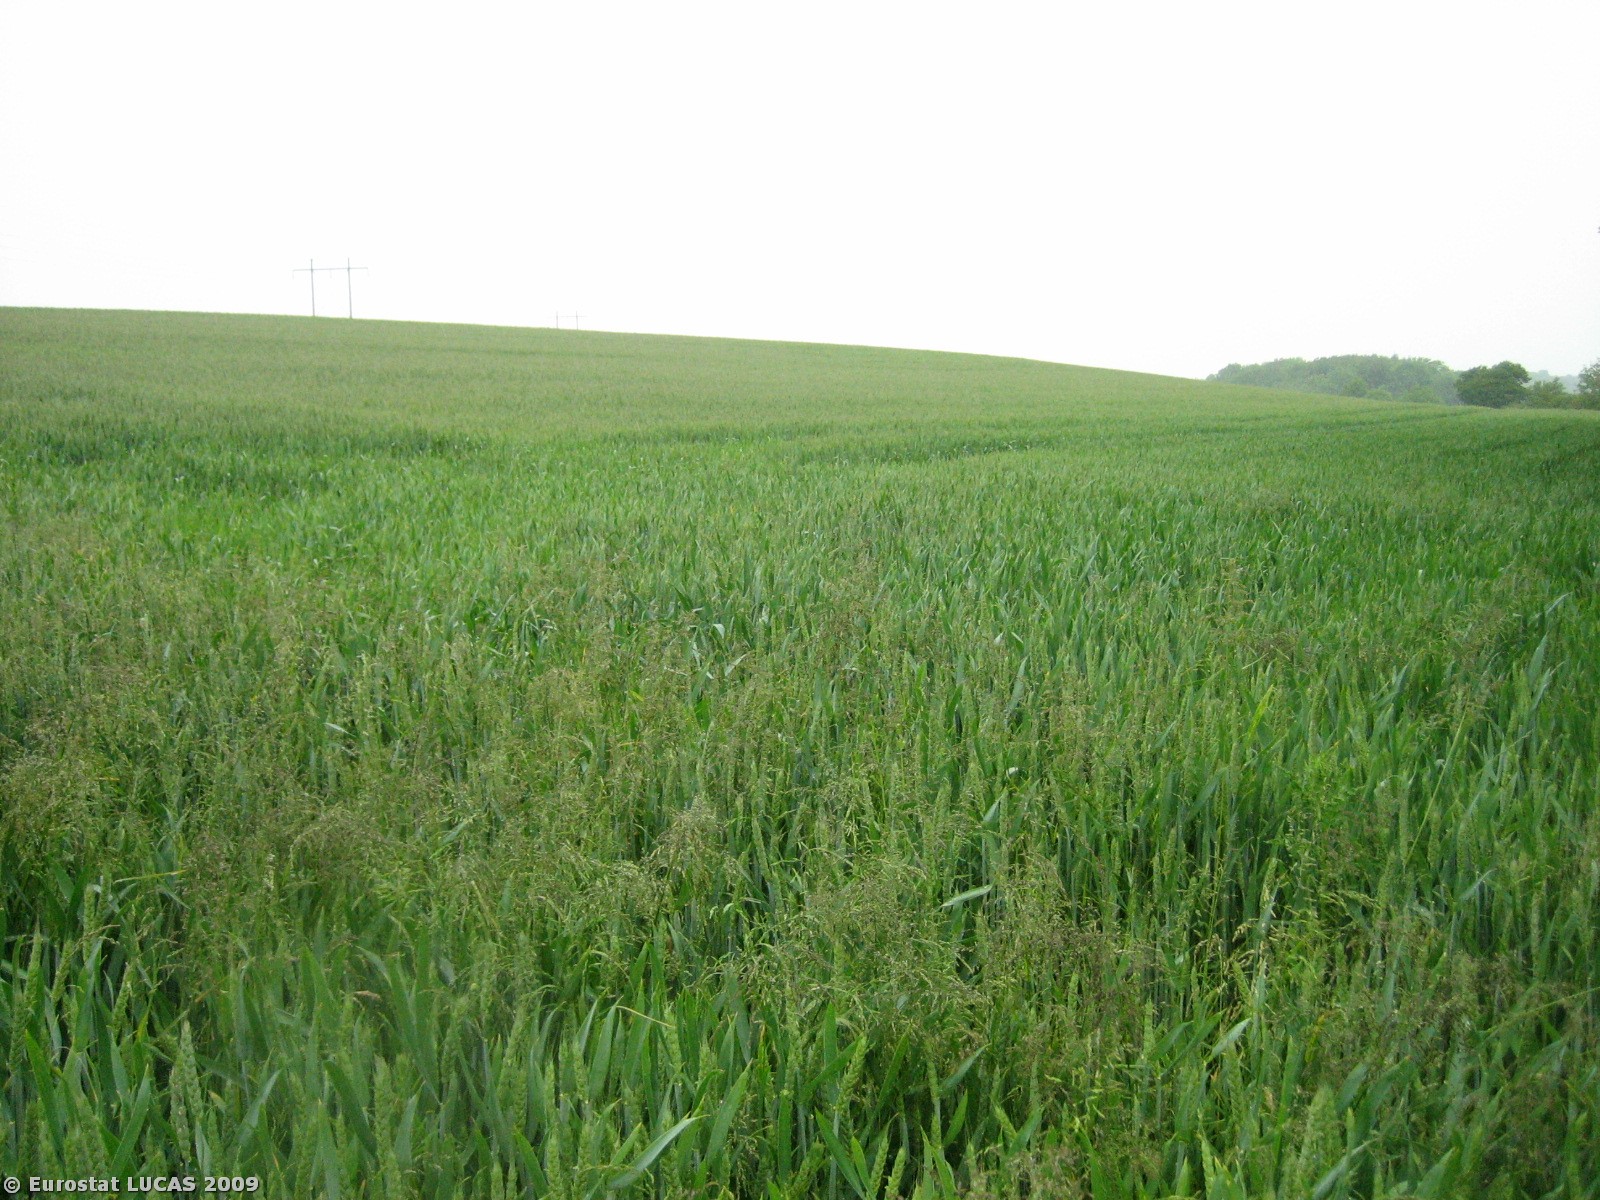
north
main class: Cropland
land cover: Common wheat
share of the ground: > 75 %
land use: Agriculture (excluding fallow land and kitchen gardens)
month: June
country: DK
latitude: 56.0079
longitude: 10.1442
